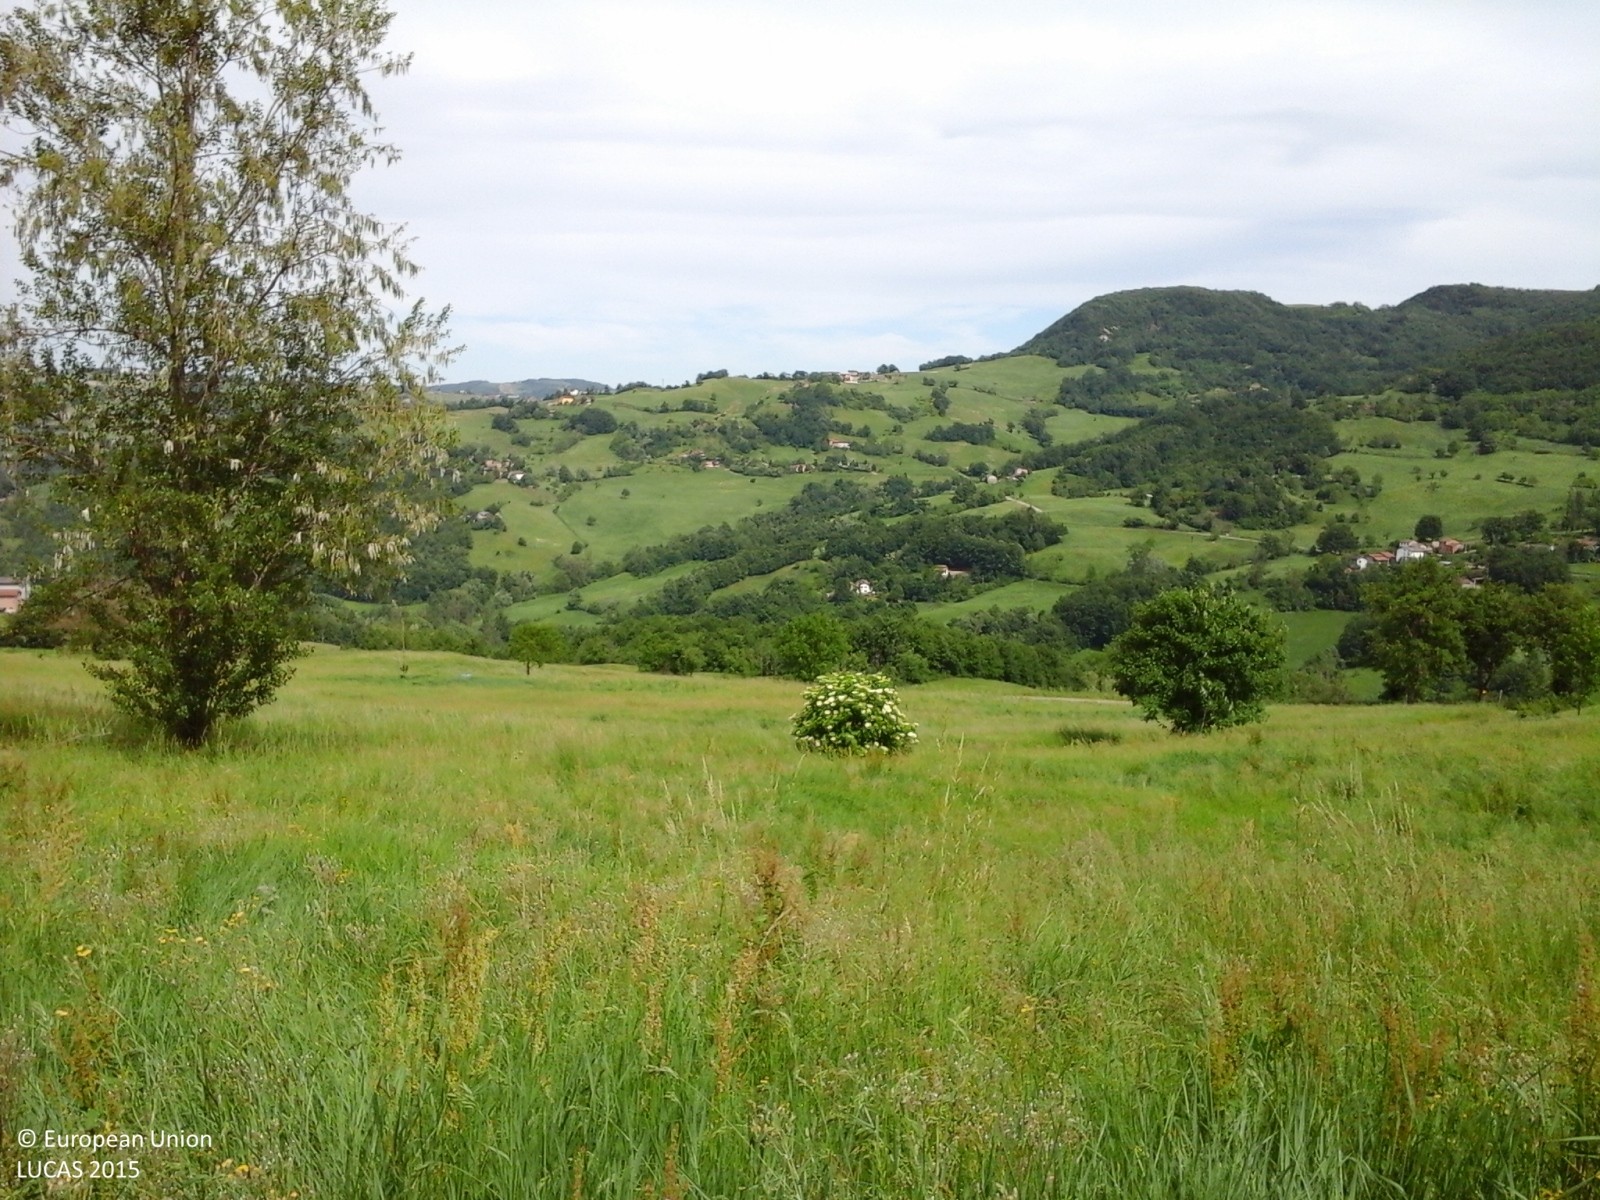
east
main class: Grassland
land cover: Spontaneously vegetated surfaces
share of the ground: > 75 %
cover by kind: herbaceous plants 100 %
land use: Agriculture (excluding fallow land and kitchen gardens)
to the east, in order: Spontaneously vegetated surfaces; Tracks; Spontaneously vegetated surfaces; Paved roads, cycling and walking lanes; Spontaneously vegetated surfaces
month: May
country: IT
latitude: 44.3479
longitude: 10.7384
